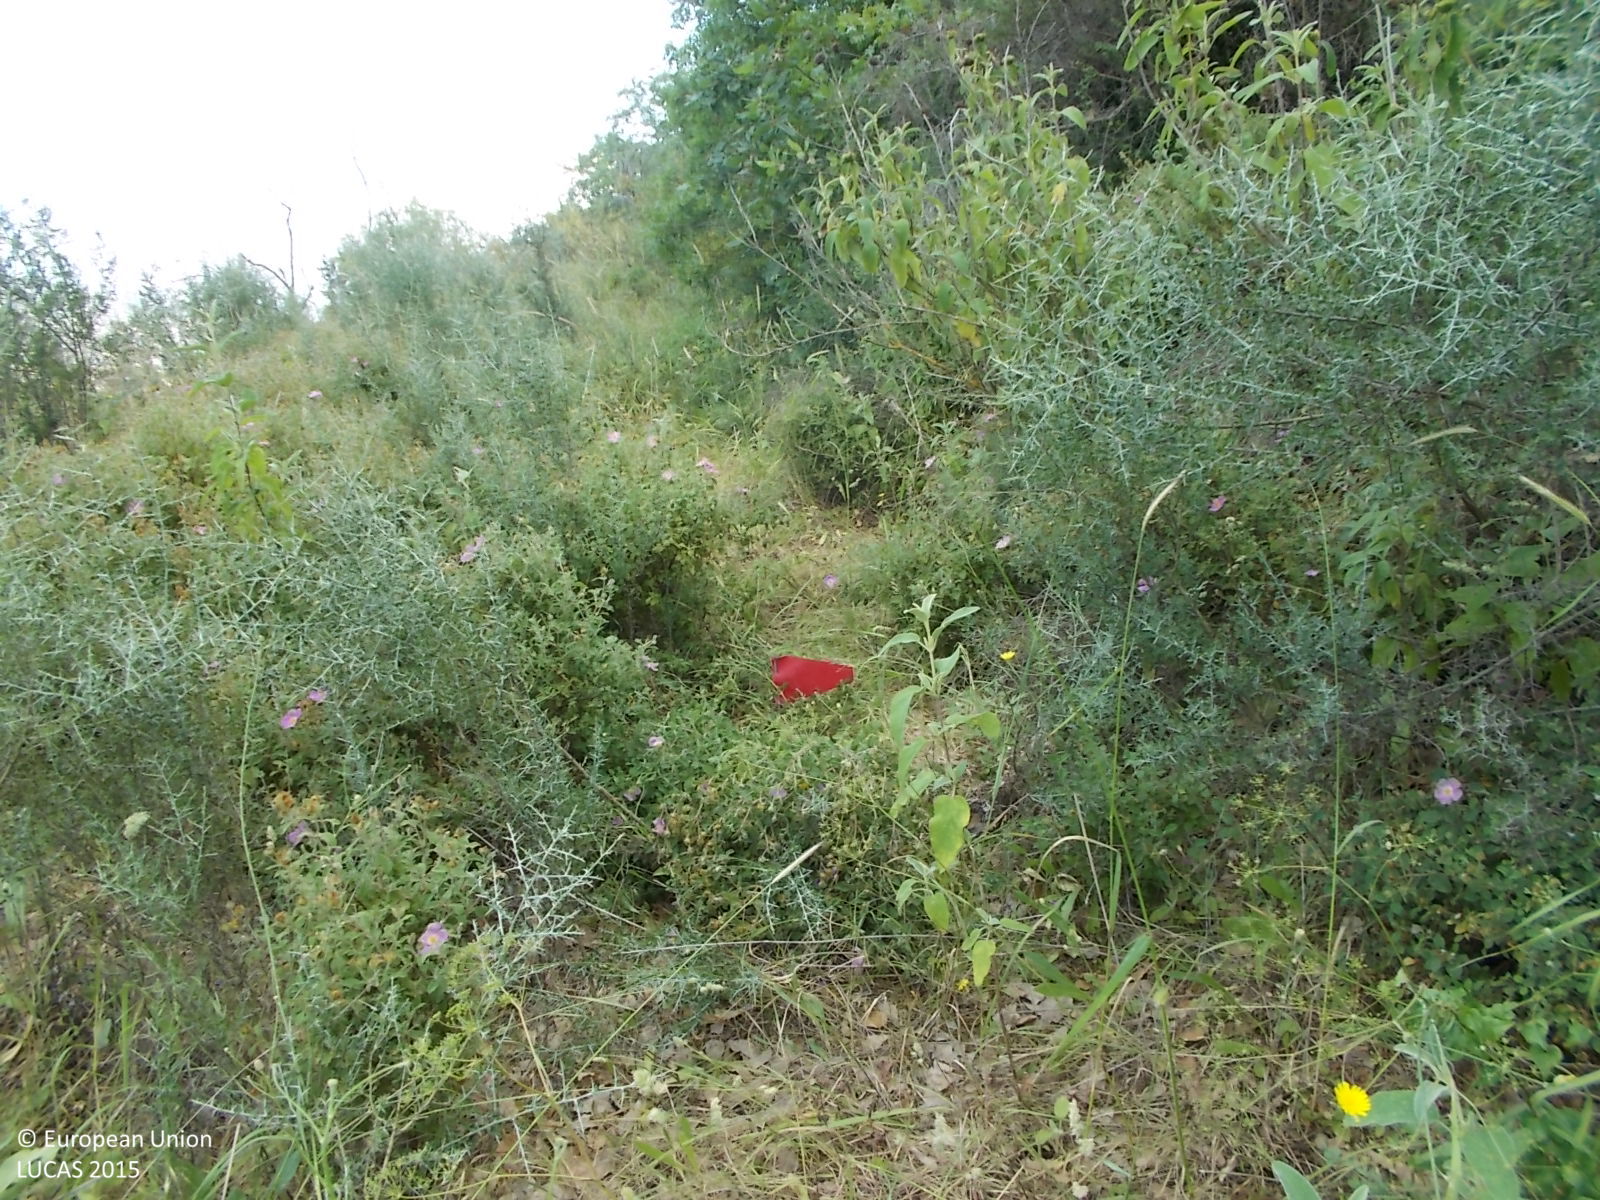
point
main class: Shrubland
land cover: Shrubland with sparse tree cover
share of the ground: > 75 %
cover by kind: shrubs 85 %, herbaceous plants 10 %, broadleaved forest trees 5 %
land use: Semi-natural and natural areas not in use
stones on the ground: < 10 %
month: May
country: CY
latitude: 34.9498
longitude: 32.4570
